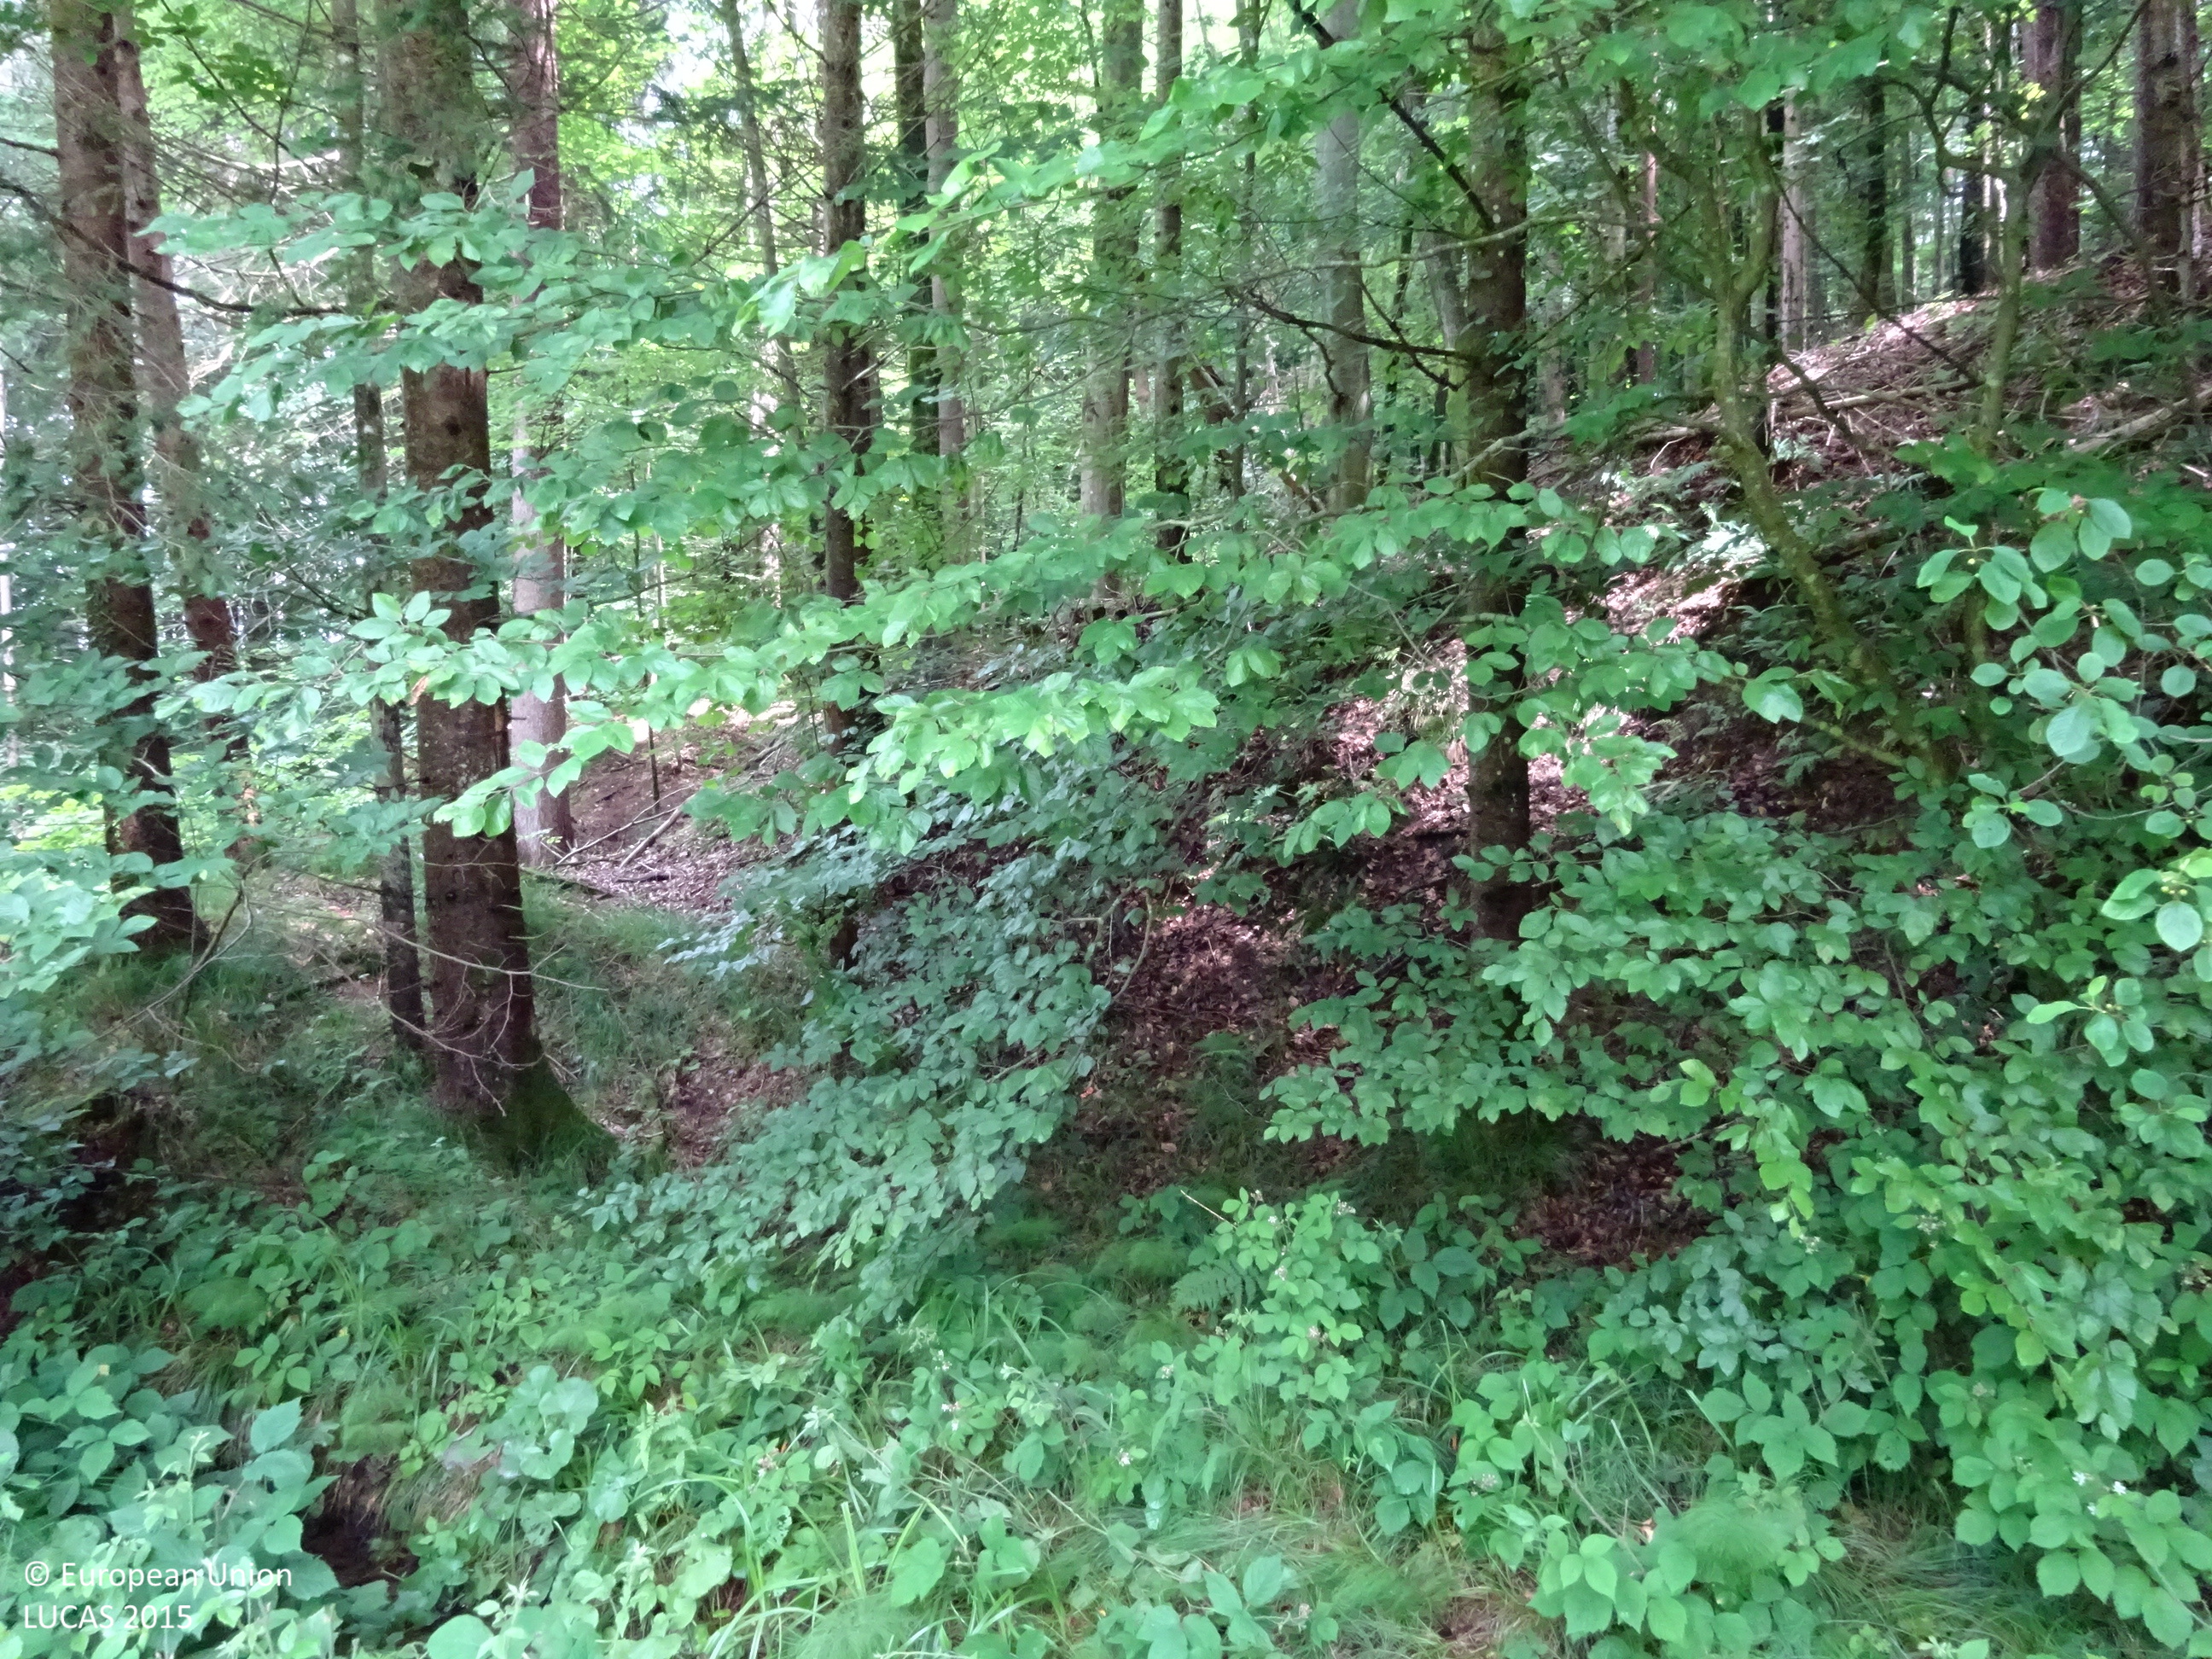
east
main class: Grassland
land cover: Spontaneously vegetated surfaces
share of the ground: > 75 %
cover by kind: herbaceous plants 100 %
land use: Semi-natural and natural areas not in use
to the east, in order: Rivers and streams; Spruce dominated mixed woodland; Pine dominated mixed woodland
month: June
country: AT
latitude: 46.7458
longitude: 15.2476
